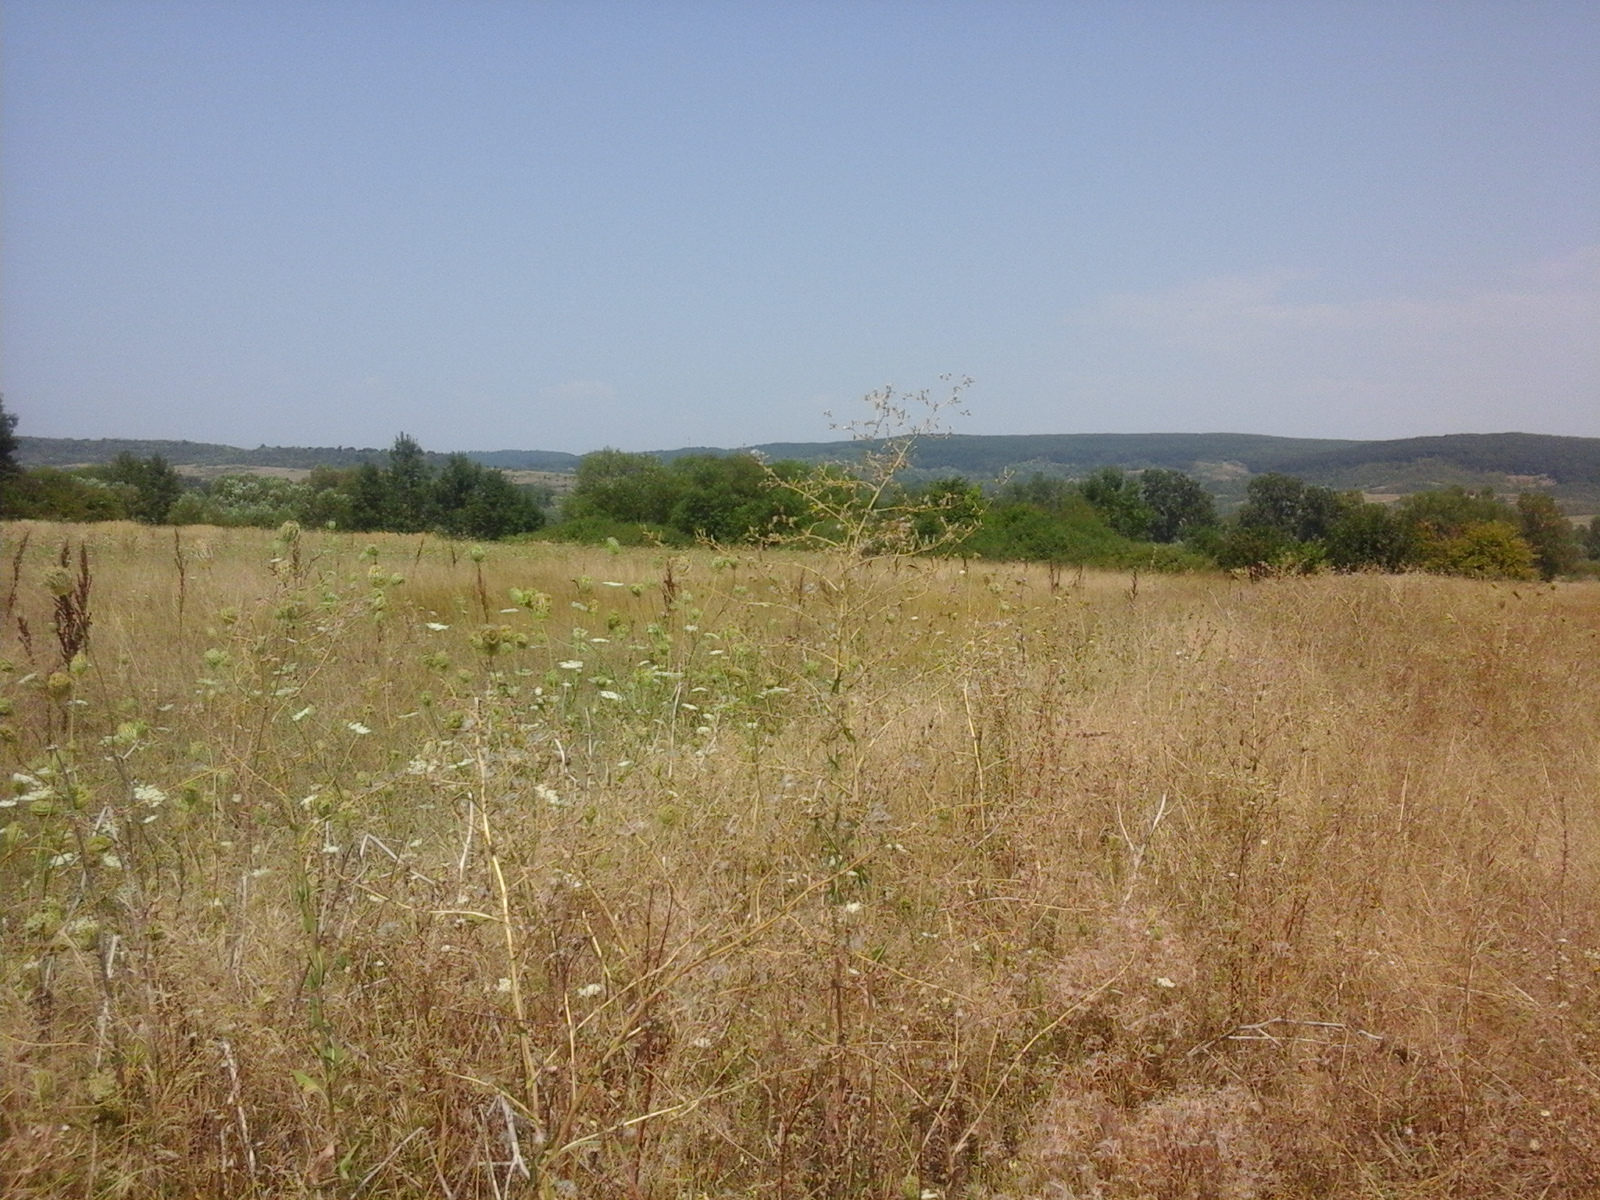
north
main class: Grassland
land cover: Spontaneously vegetated surfaces
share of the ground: > 75 %
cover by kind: herbaceous plants 100 %
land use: Agriculture (excluding fallow land and kitchen gardens)
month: August
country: RO
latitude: 44.5838
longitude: 23.3136
